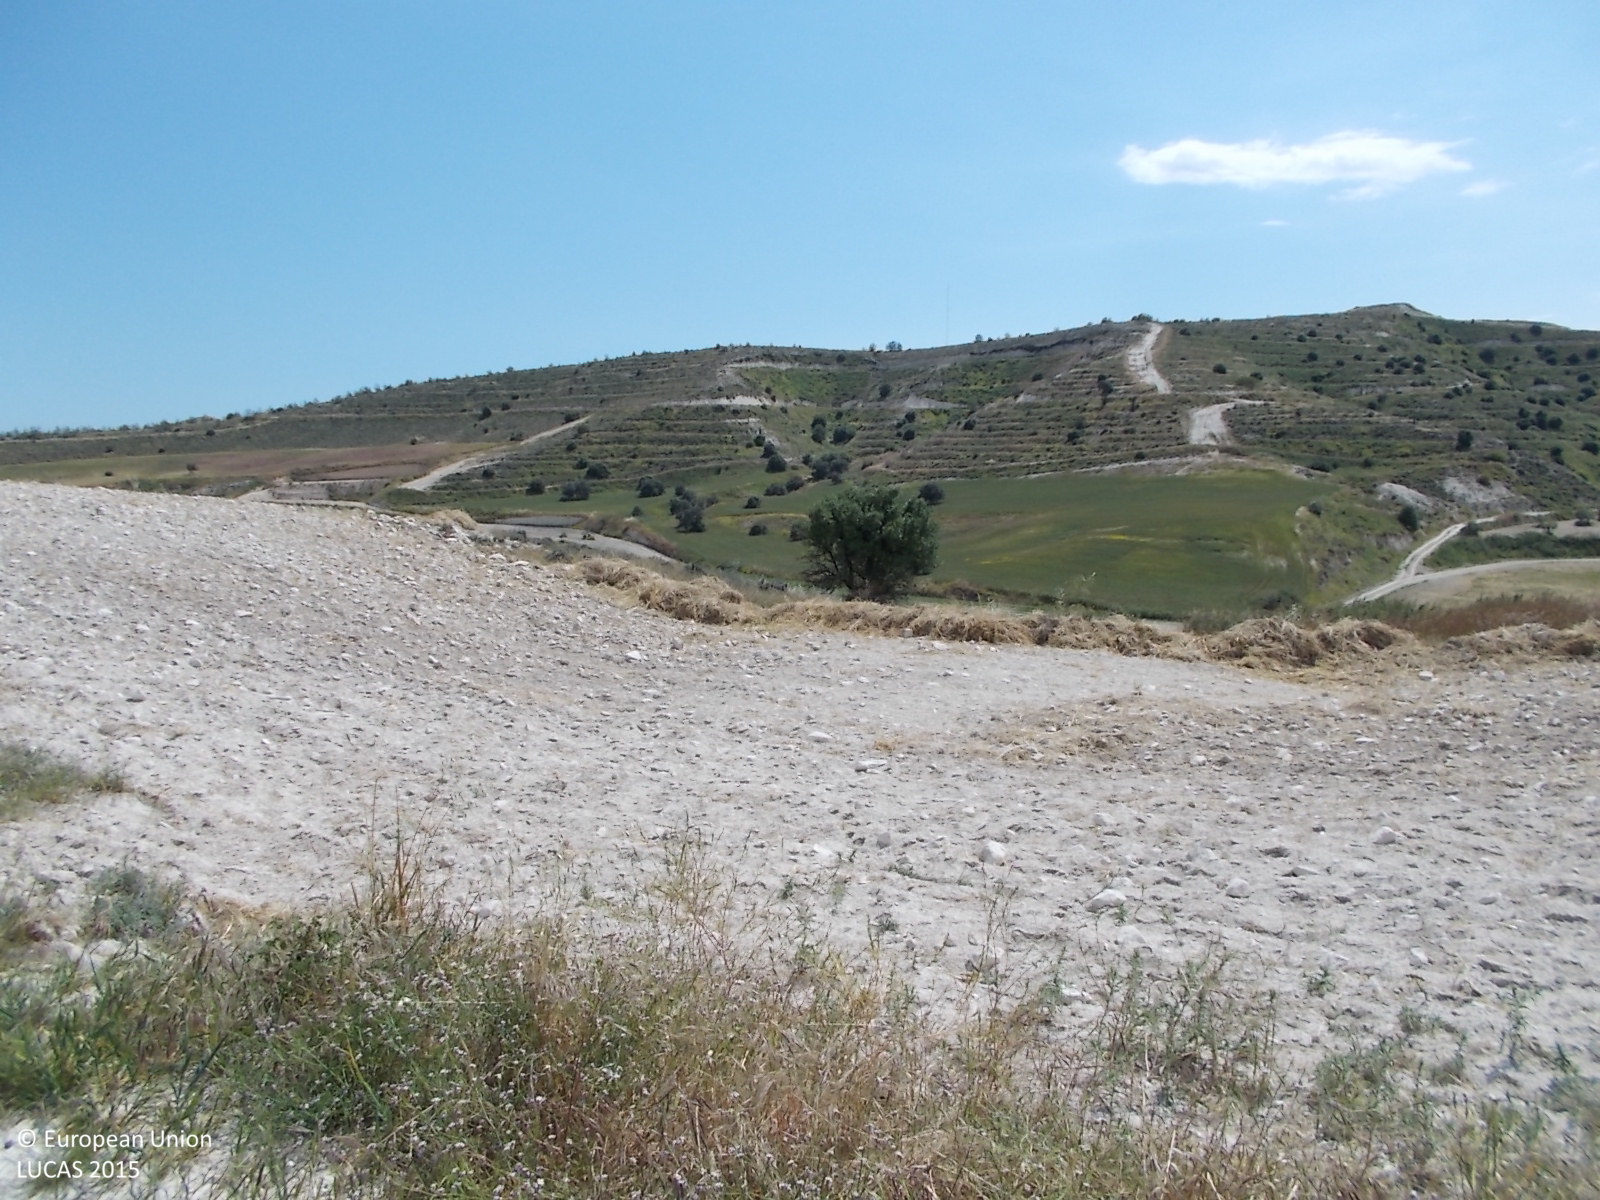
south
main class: Grassland
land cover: Spontaneously vegetated surfaces
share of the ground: > 75 %
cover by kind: herbaceous plants 85 %, unconsolidated bare surface 15 %
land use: Fallow land
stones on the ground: 10 - 25 %
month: April
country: CY
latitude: 34.9924
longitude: 33.6107
